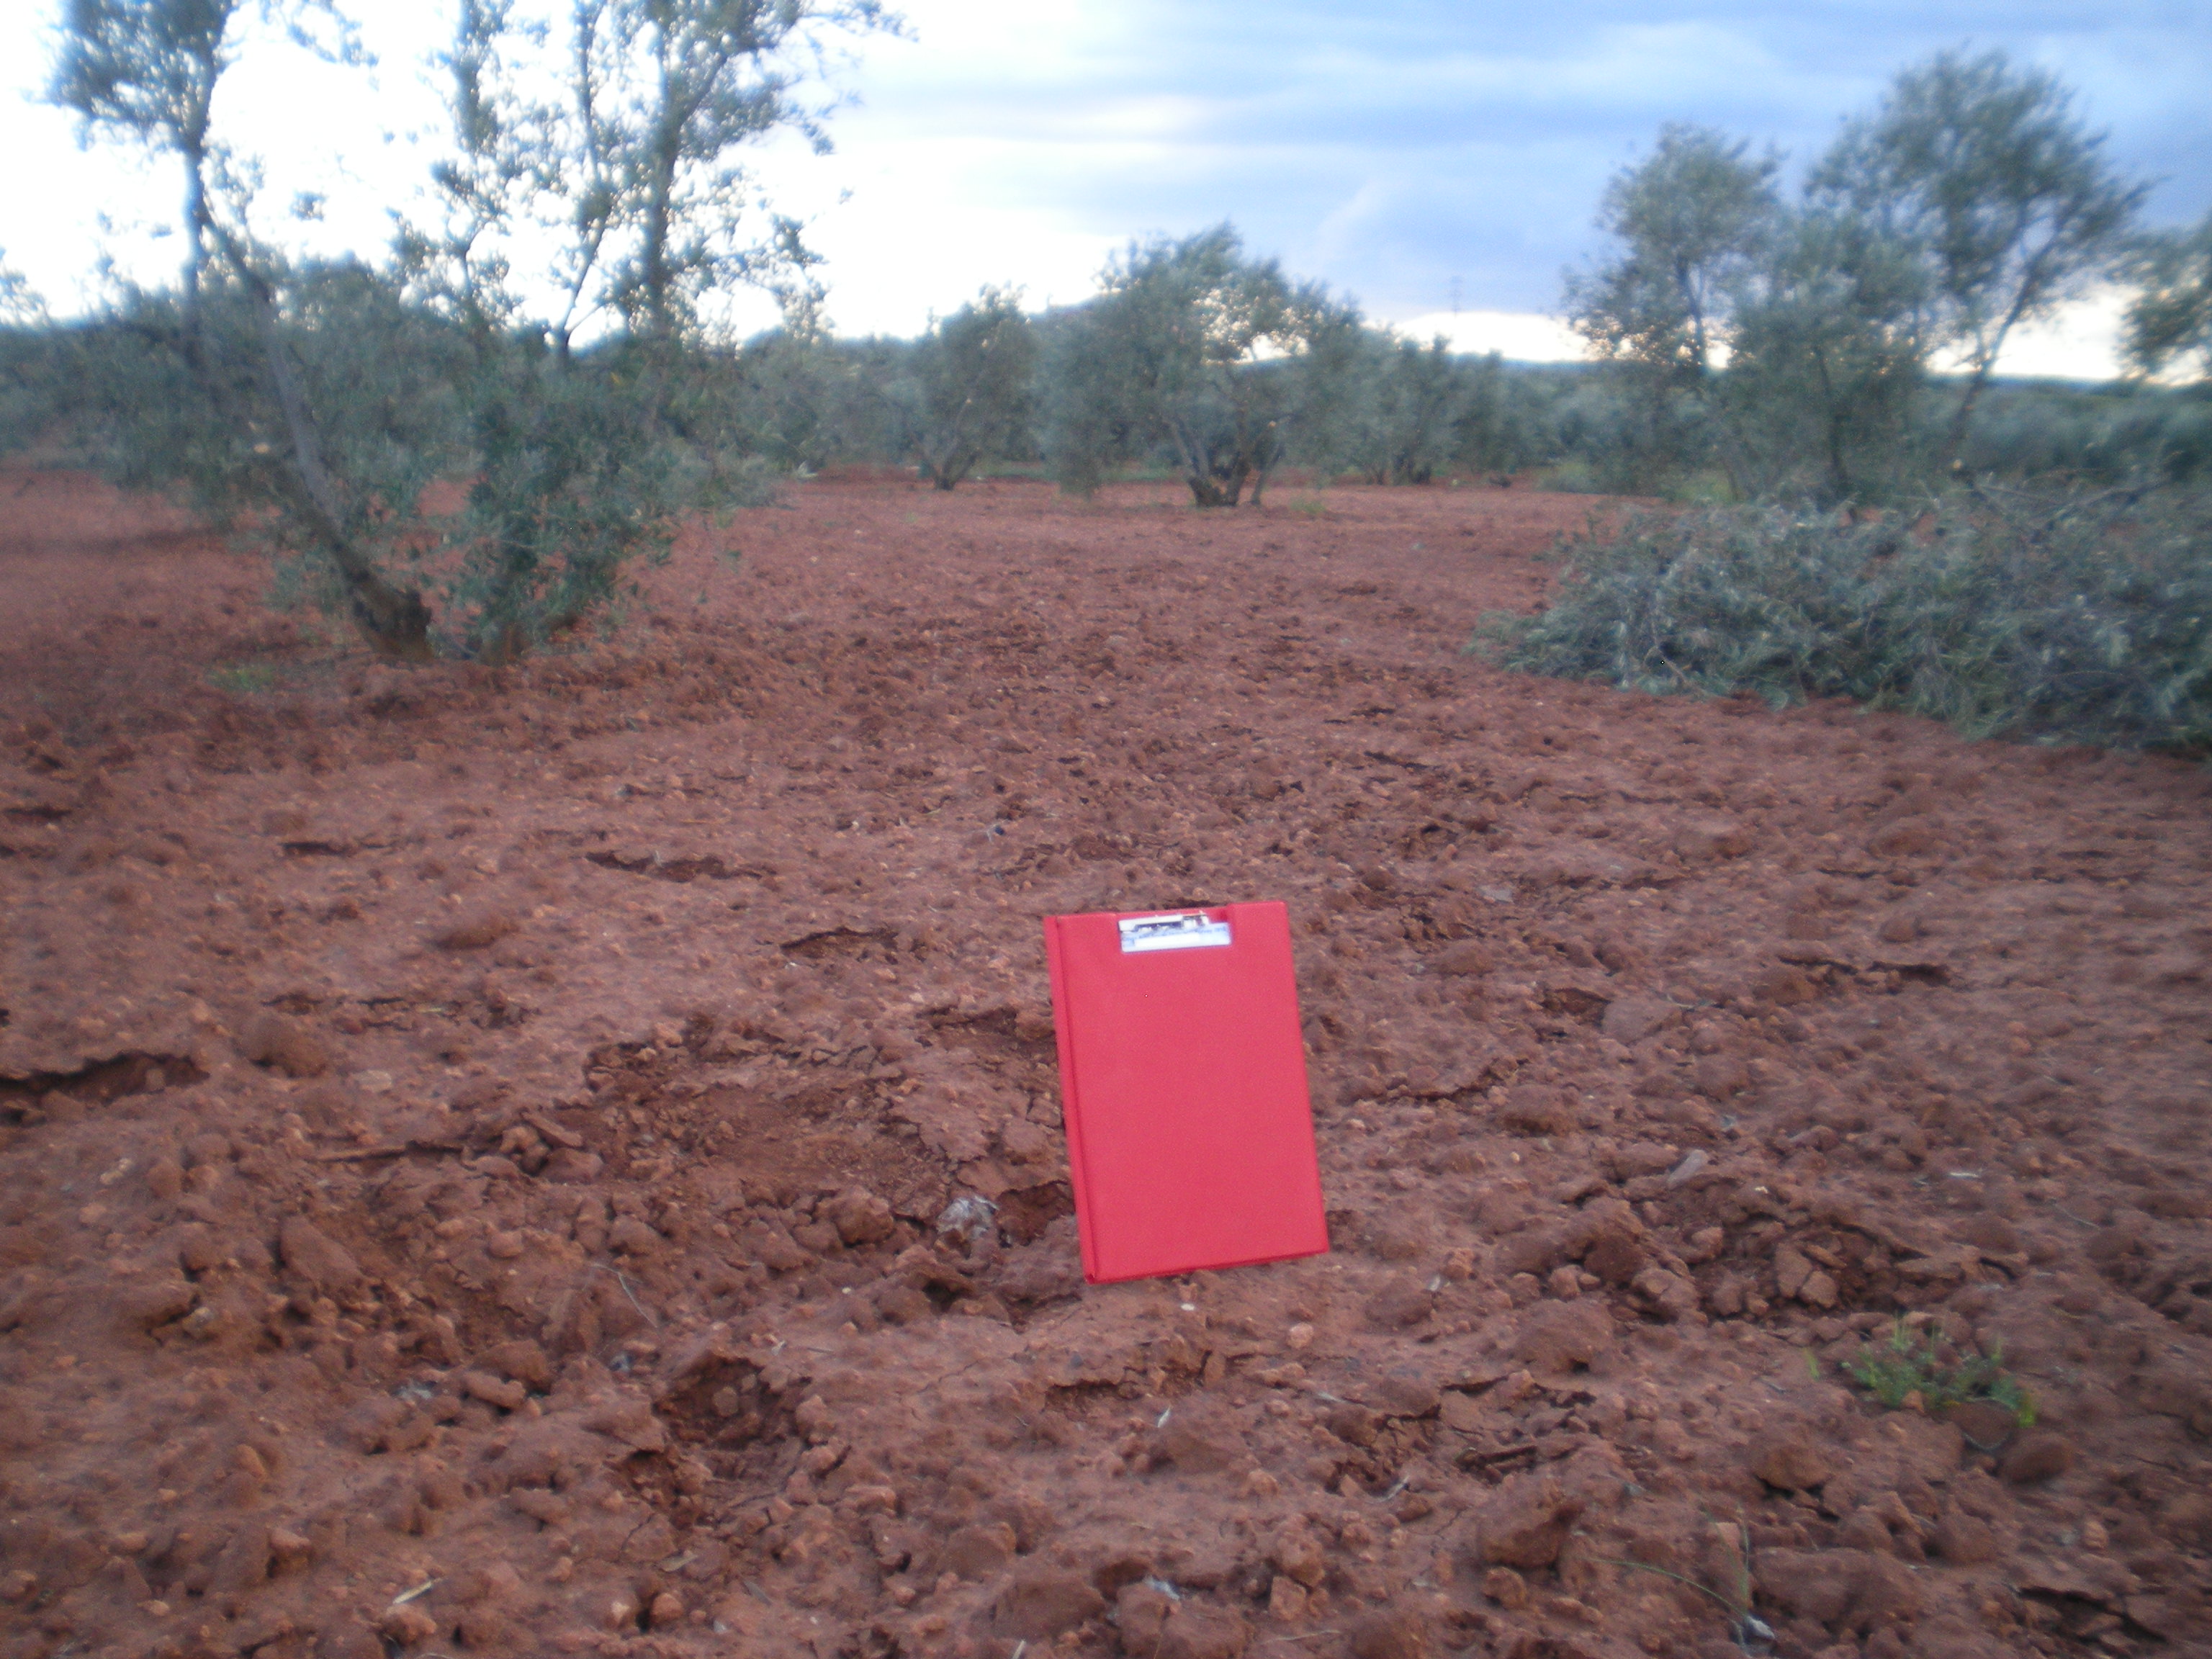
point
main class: Cropland
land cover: Olive groves
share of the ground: 10 - 25 %
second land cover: Other bare soil
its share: > 75 %
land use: Agriculture (excluding fallow land and kitchen gardens)
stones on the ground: < 10 %
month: April
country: ES
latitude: 38.6479
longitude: -3.3953
